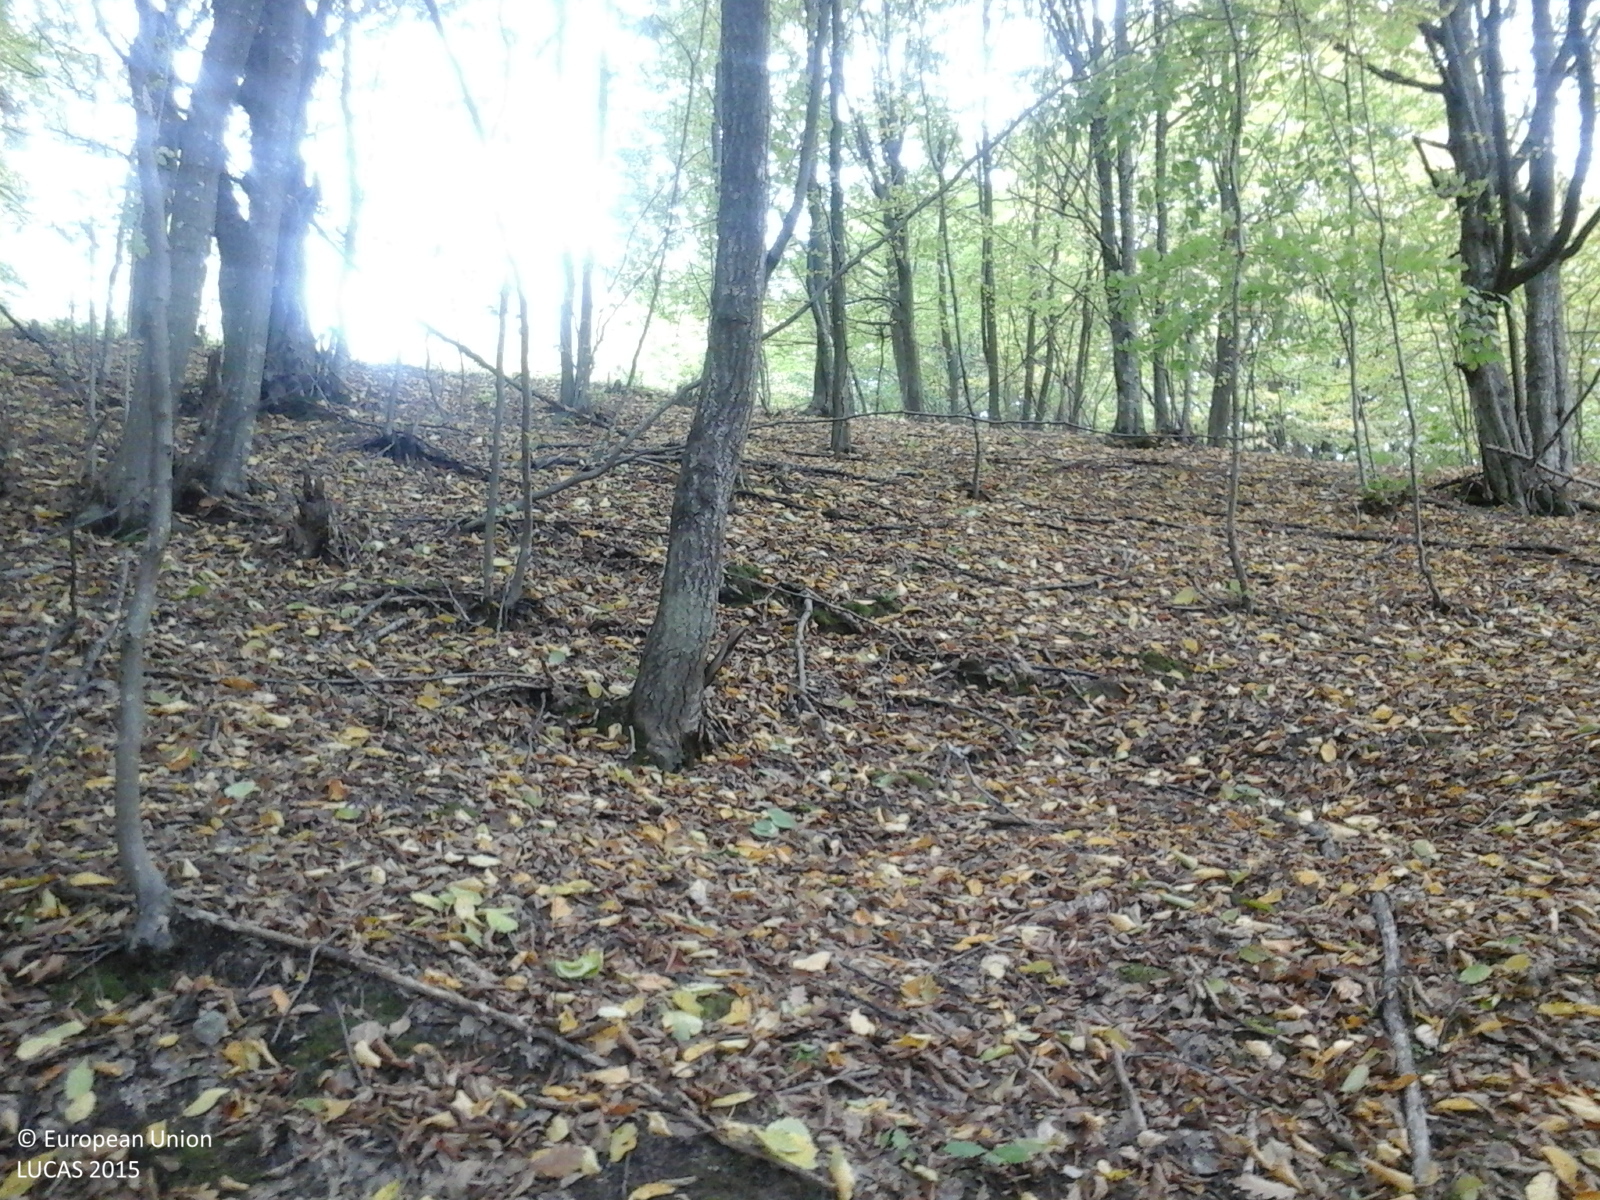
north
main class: Woodland
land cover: Broadleaved woodland
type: mesophytic deciduous forest
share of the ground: > 75 %
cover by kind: broadleaved forest trees 100 %
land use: Forestry
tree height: > 5 m
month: October
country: RO
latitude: 46.0067
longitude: 25.8292
